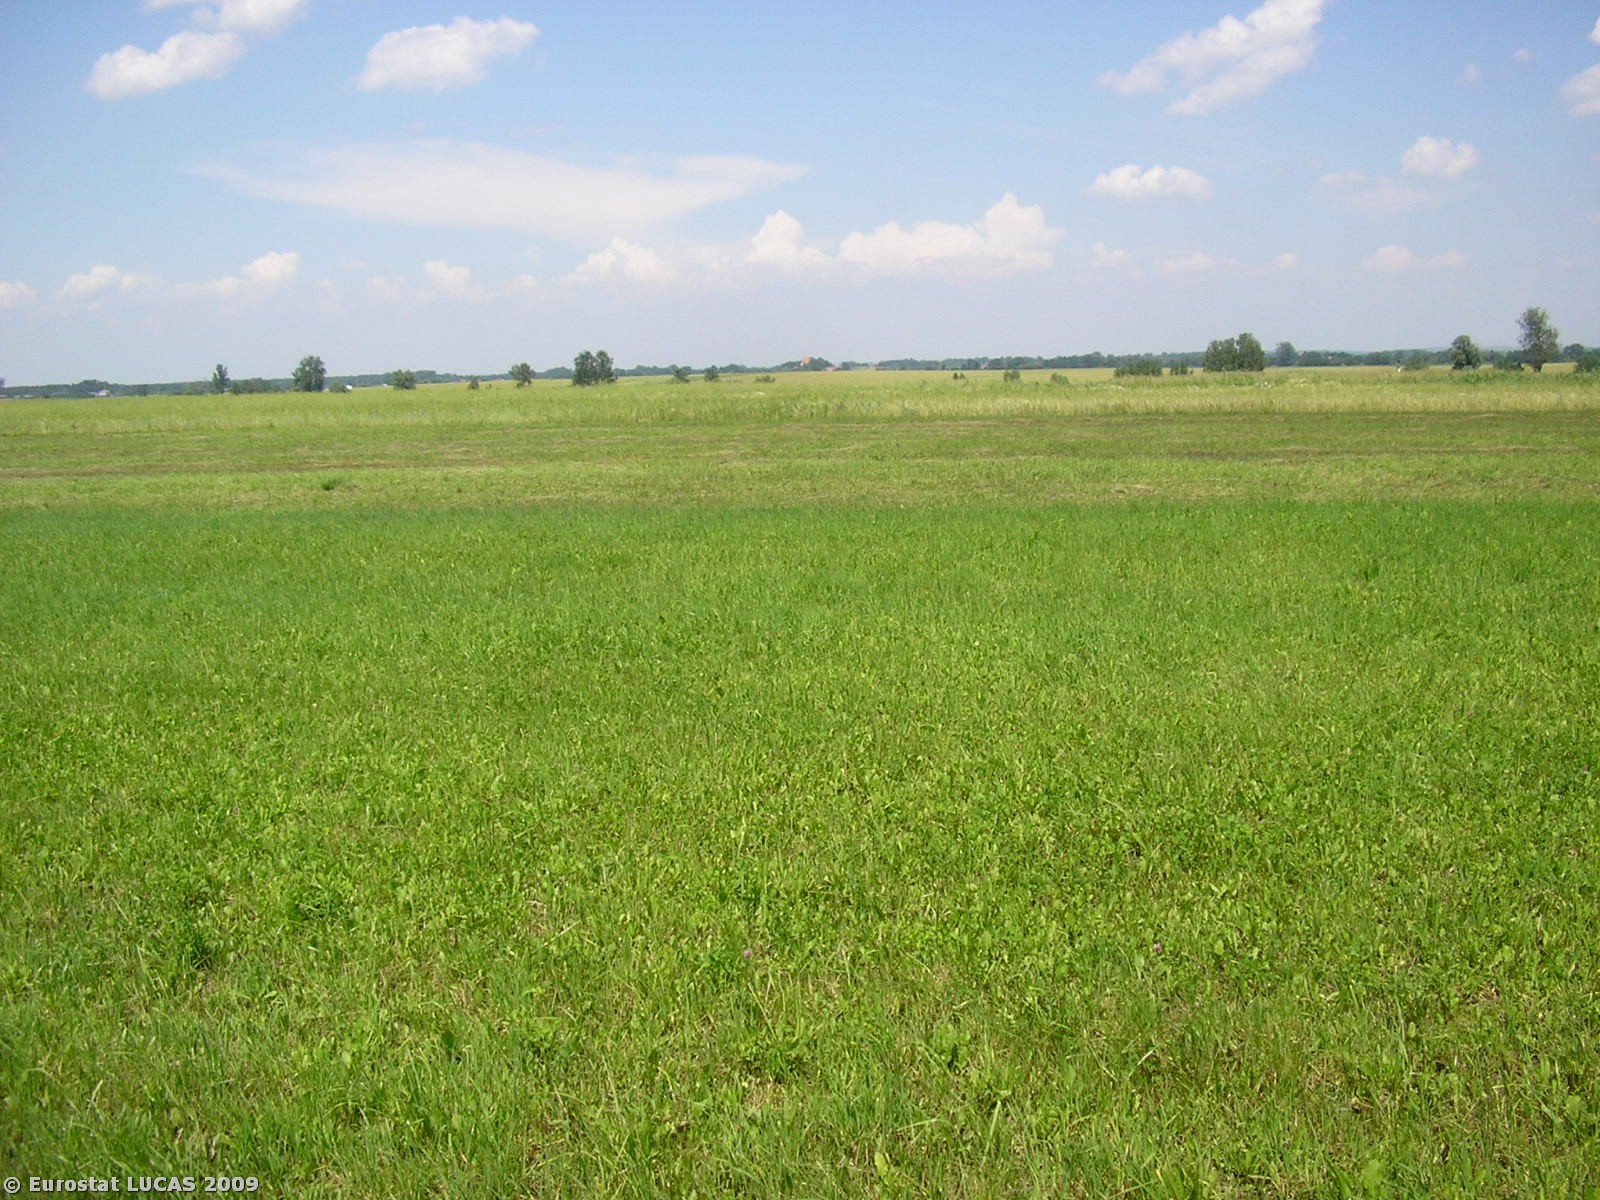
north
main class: Grassland
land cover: Grassland without tree/shrub cover
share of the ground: > 75 %
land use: Agriculture (excluding fallow land and kitchen gardens)
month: July
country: PL
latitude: 50.3498
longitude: 20.7070
